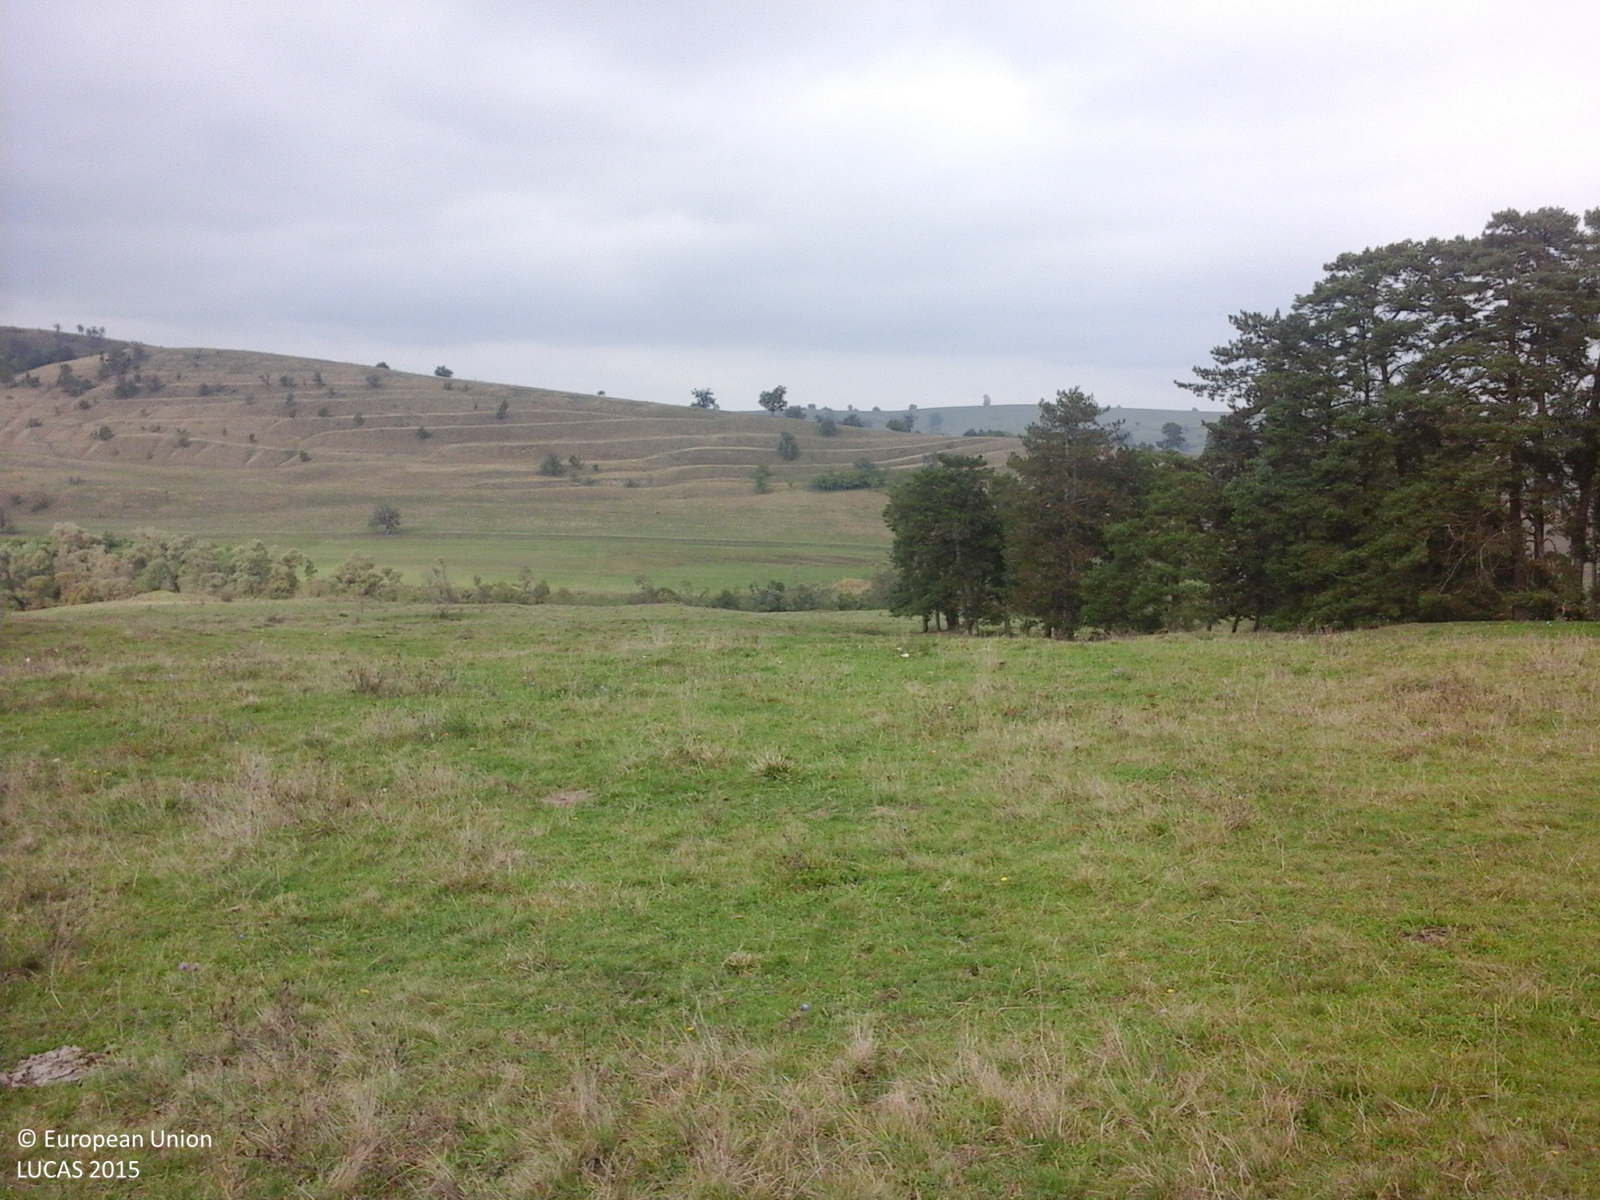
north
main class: Grassland
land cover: Grassland without tree/shrub cover
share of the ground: > 75 %
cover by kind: herbaceous plants 100 %
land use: Agriculture (excluding fallow land and kitchen gardens)
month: October
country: RO
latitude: 45.9382
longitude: 25.1750
